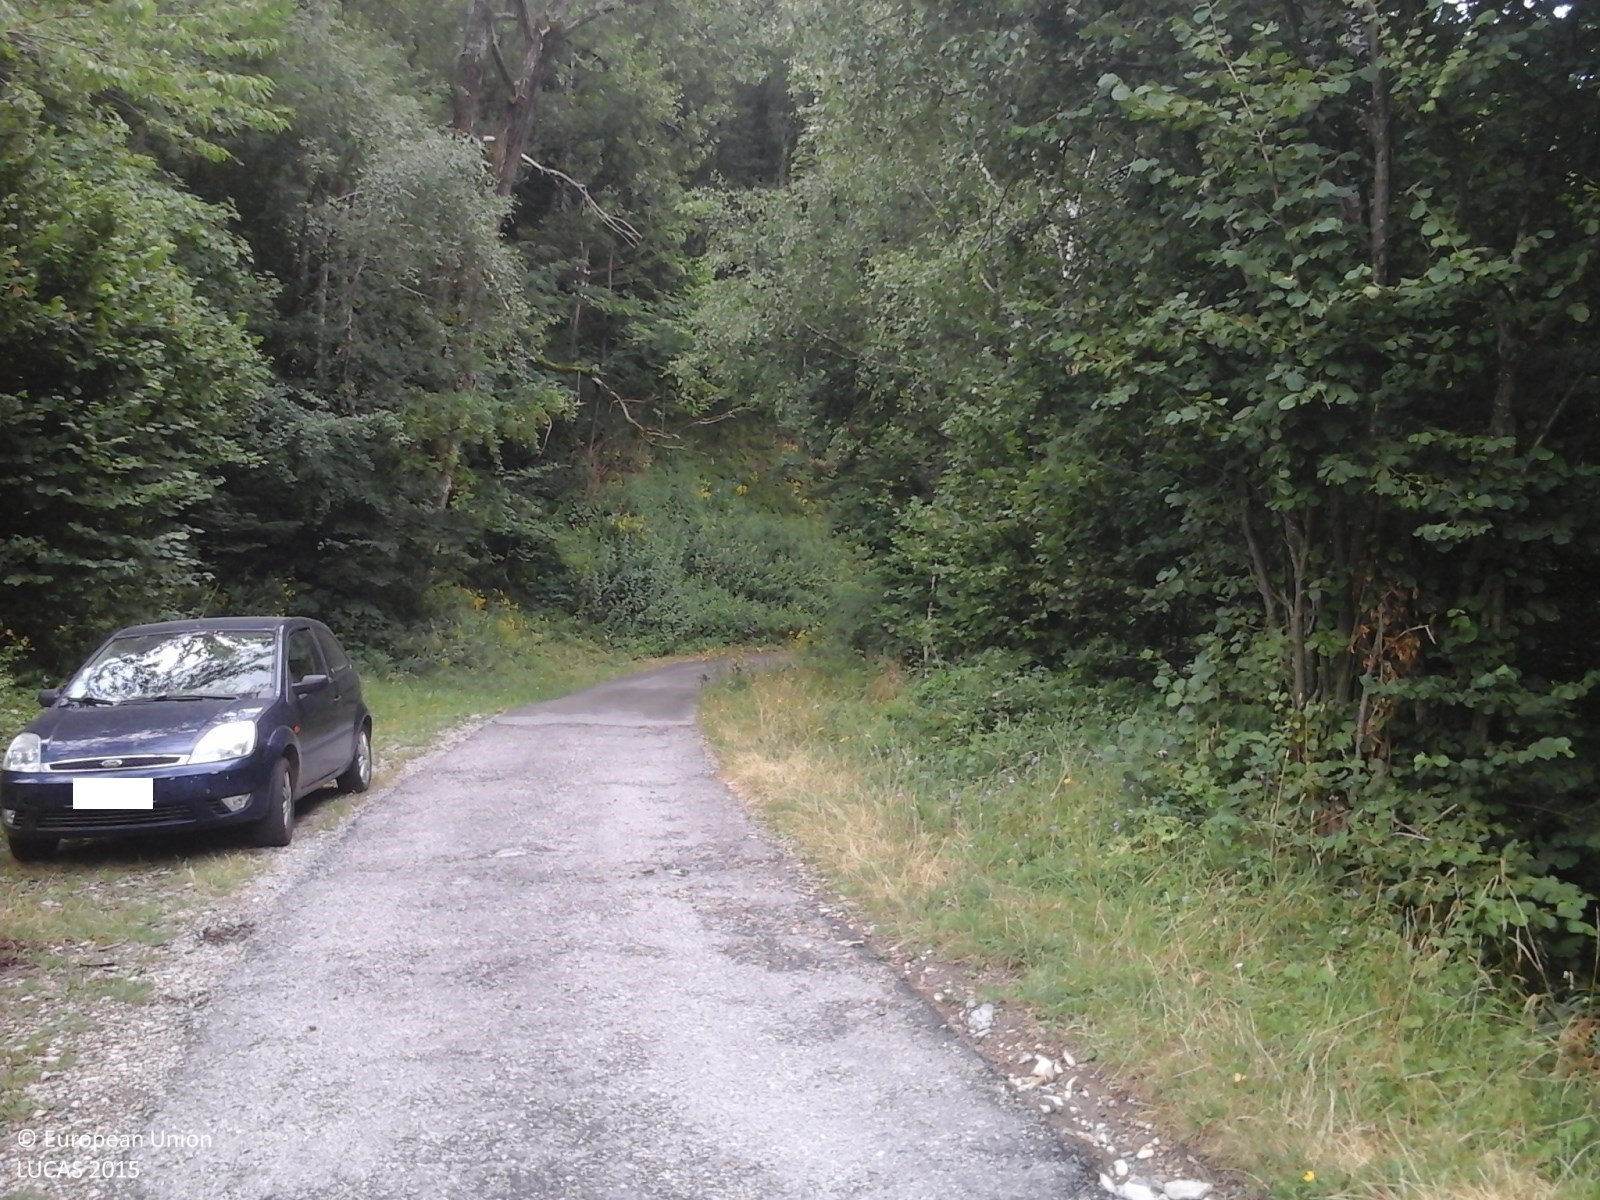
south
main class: Grassland
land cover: Grassland without tree/shrub cover
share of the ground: > 75 %
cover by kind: herbaceous plants 100 %
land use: Agriculture (excluding fallow land and kitchen gardens)
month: July
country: IT
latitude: 45.9158
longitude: 9.1890
